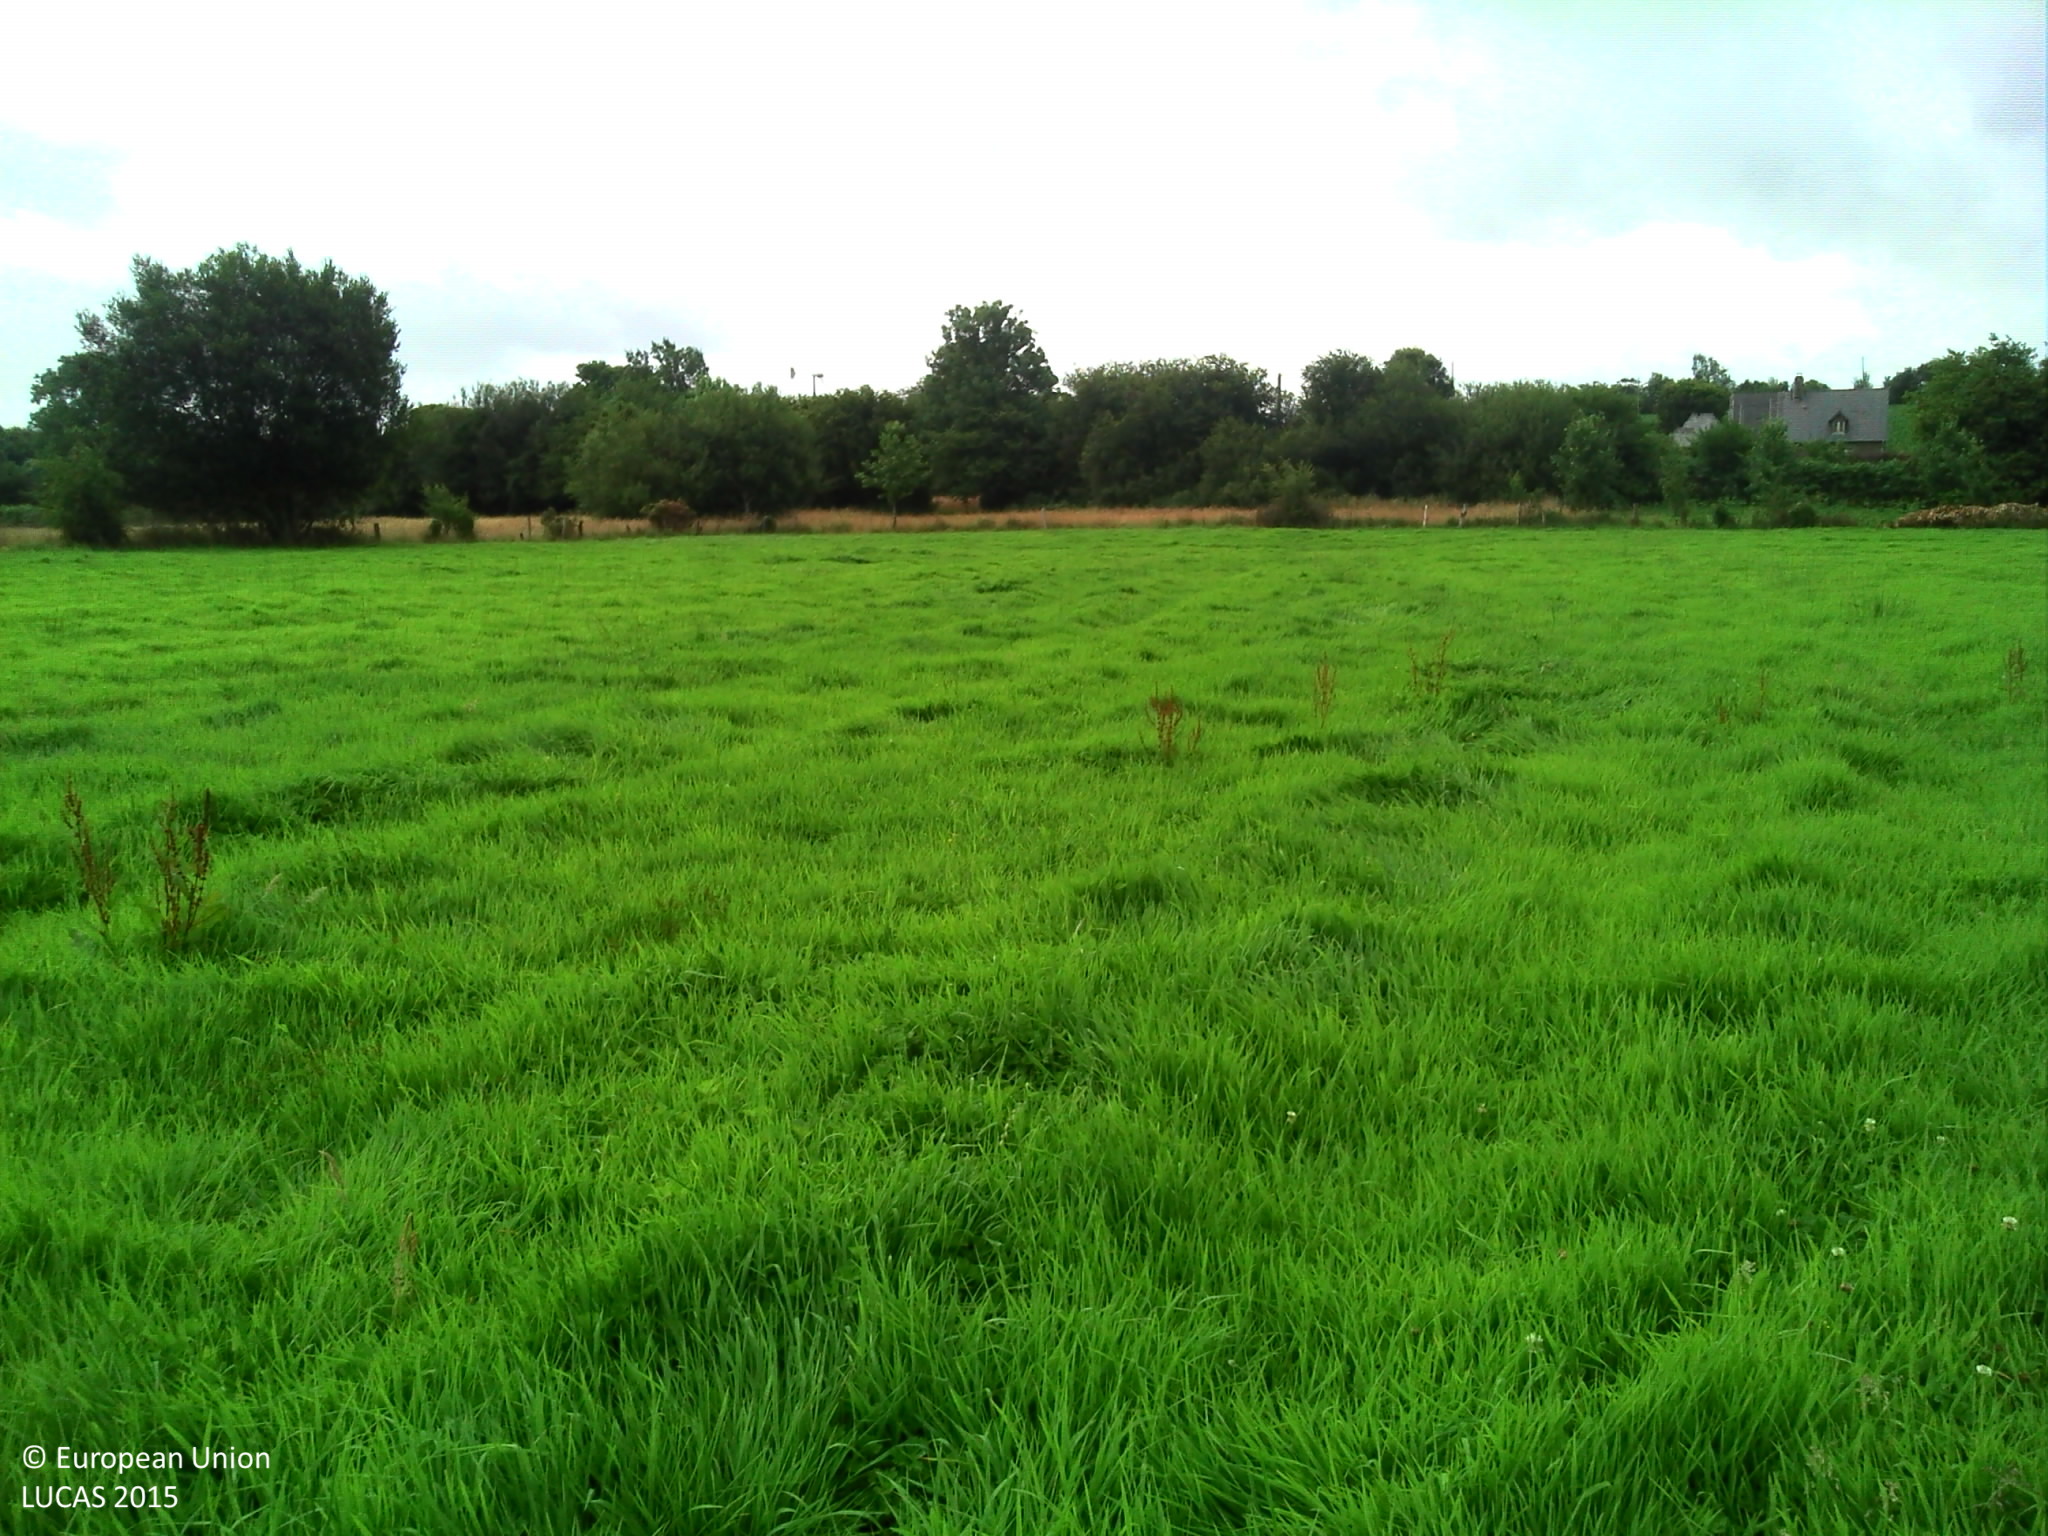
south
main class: Grassland
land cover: Grassland without tree/shrub cover
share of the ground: > 75 %
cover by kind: herbaceous plants 100 %
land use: Agriculture (excluding fallow land and kitchen gardens)
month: July
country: FR
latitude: 48.8614
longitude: -1.2632
